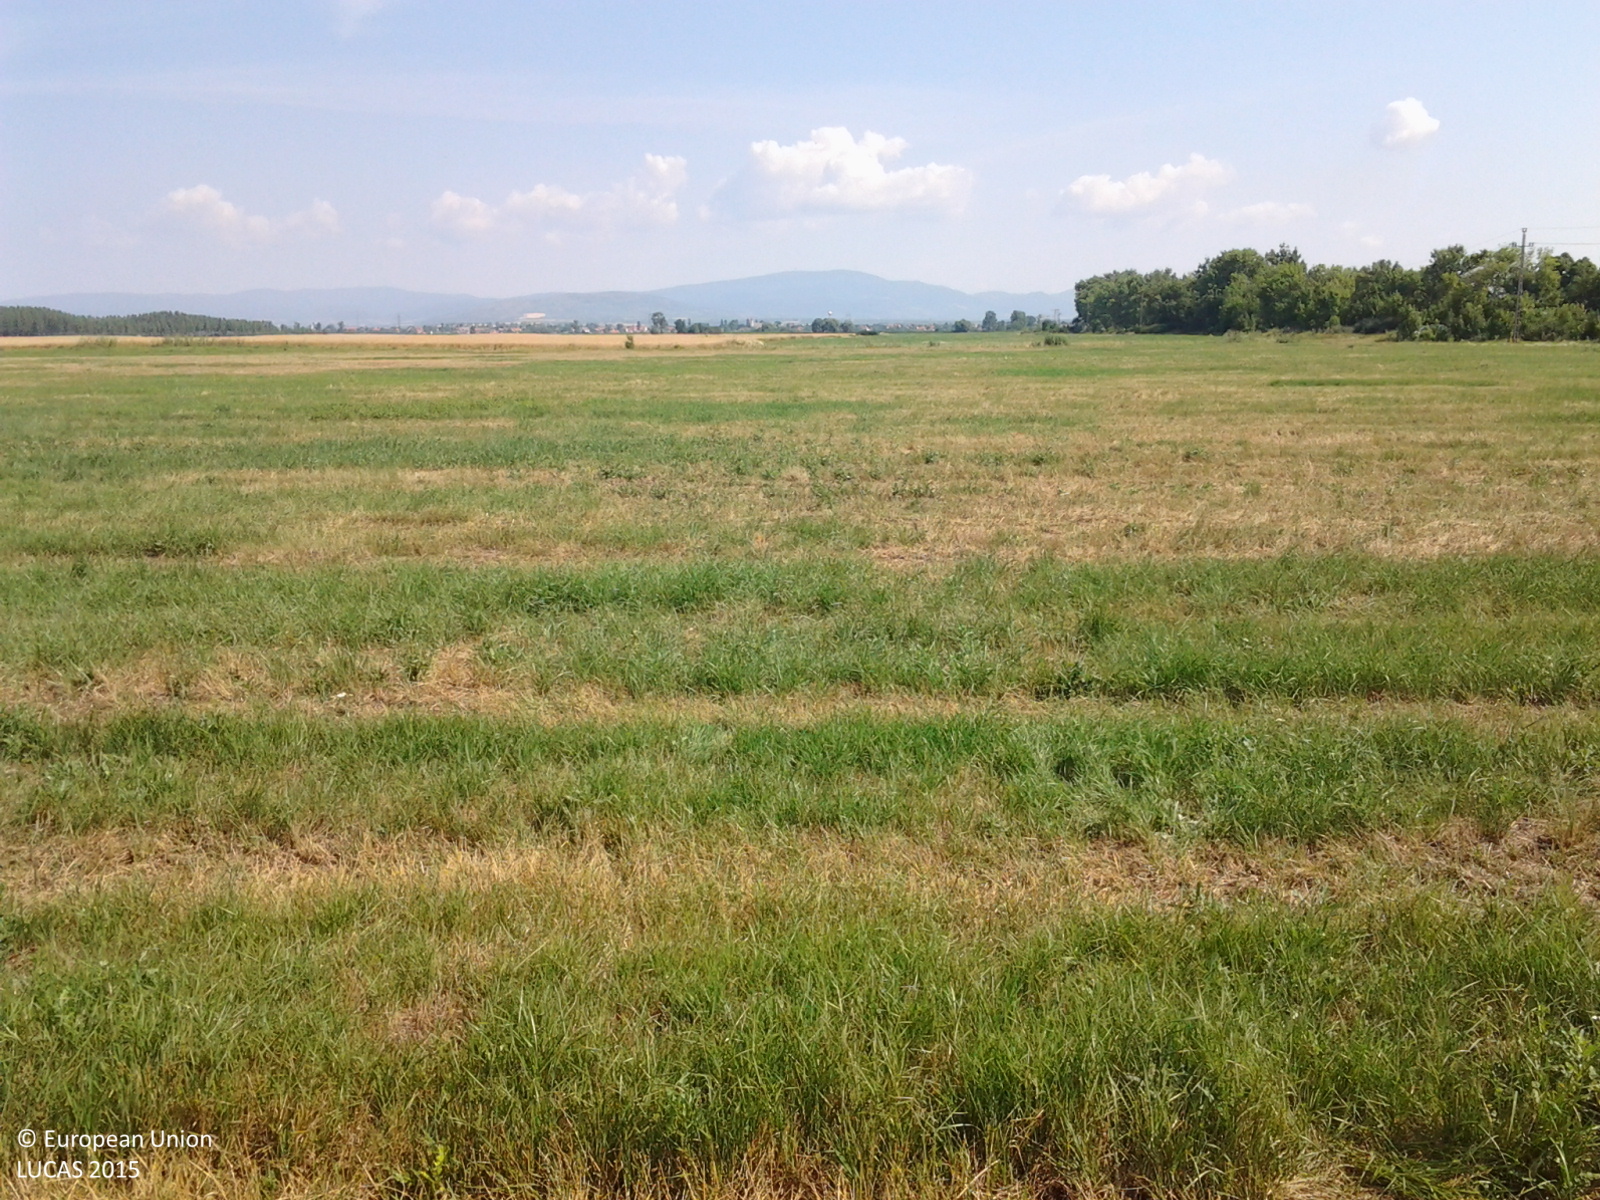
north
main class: Grassland
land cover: Grassland without tree/shrub cover
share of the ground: > 75 %
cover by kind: herbaceous plants 100 %
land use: Agriculture (excluding fallow land and kitchen gardens)
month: July
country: HU
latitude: 47.6614
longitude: 19.9734
